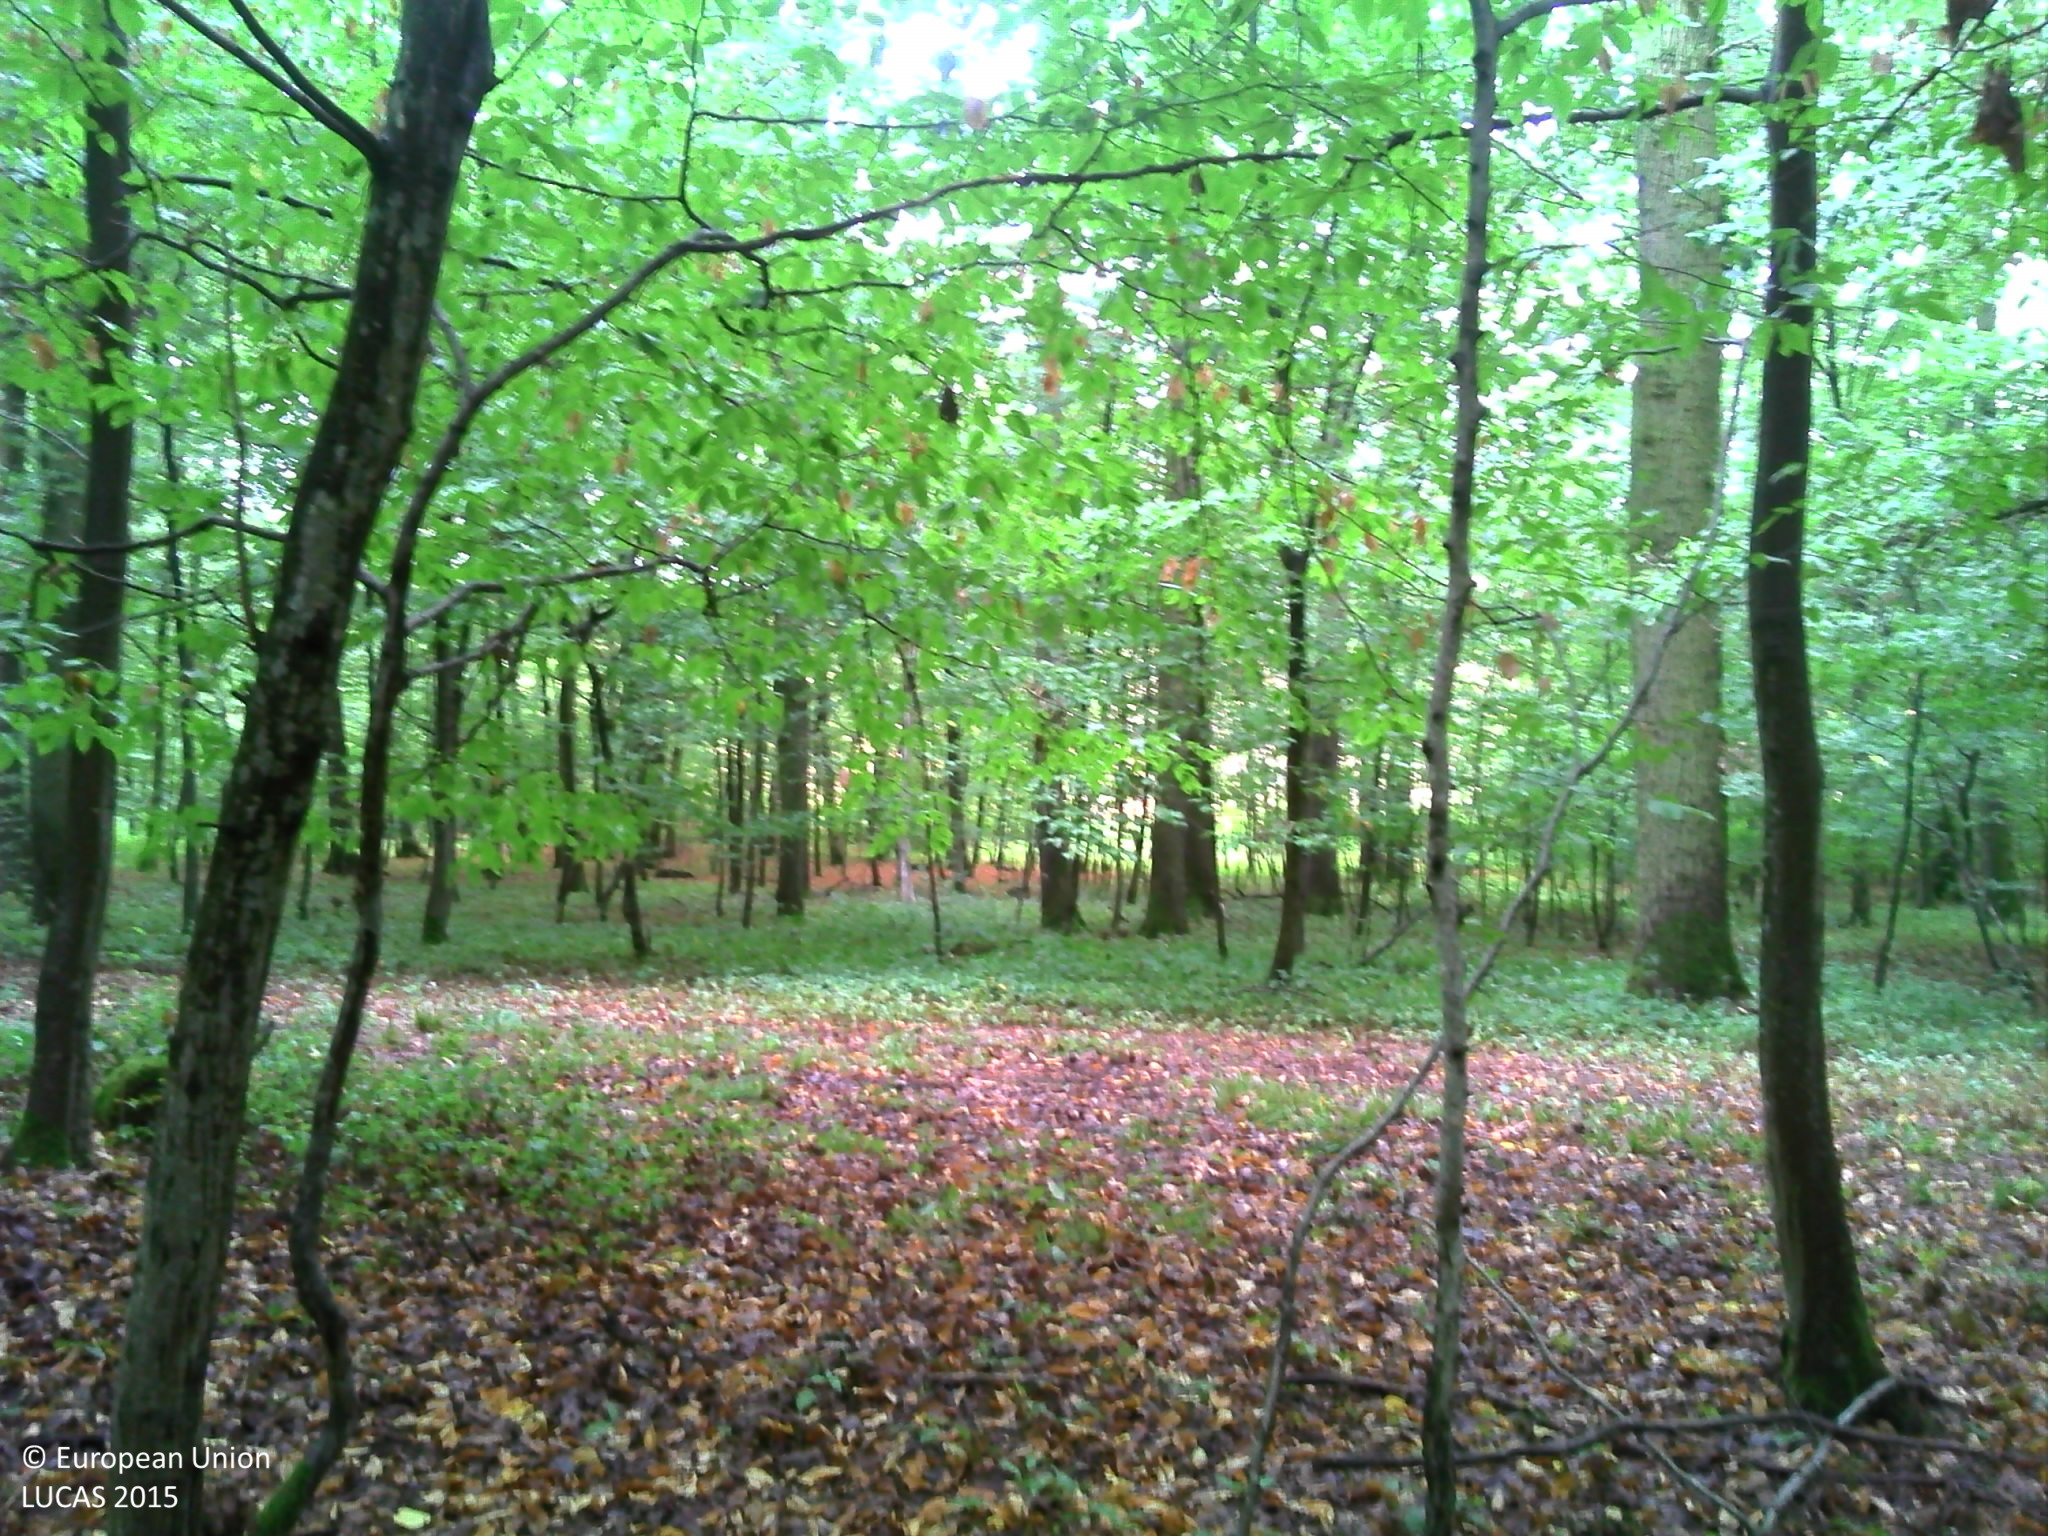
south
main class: Woodland
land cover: Broadleaved woodland
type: mesophytic deciduous forest
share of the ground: > 75 %
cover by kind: broadleaved forest trees 95 %, herbaceous plants 5 %
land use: Forestry
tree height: > 5 m
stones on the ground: < 10 %
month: August
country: FR
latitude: 48.7895
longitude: 7.5098
